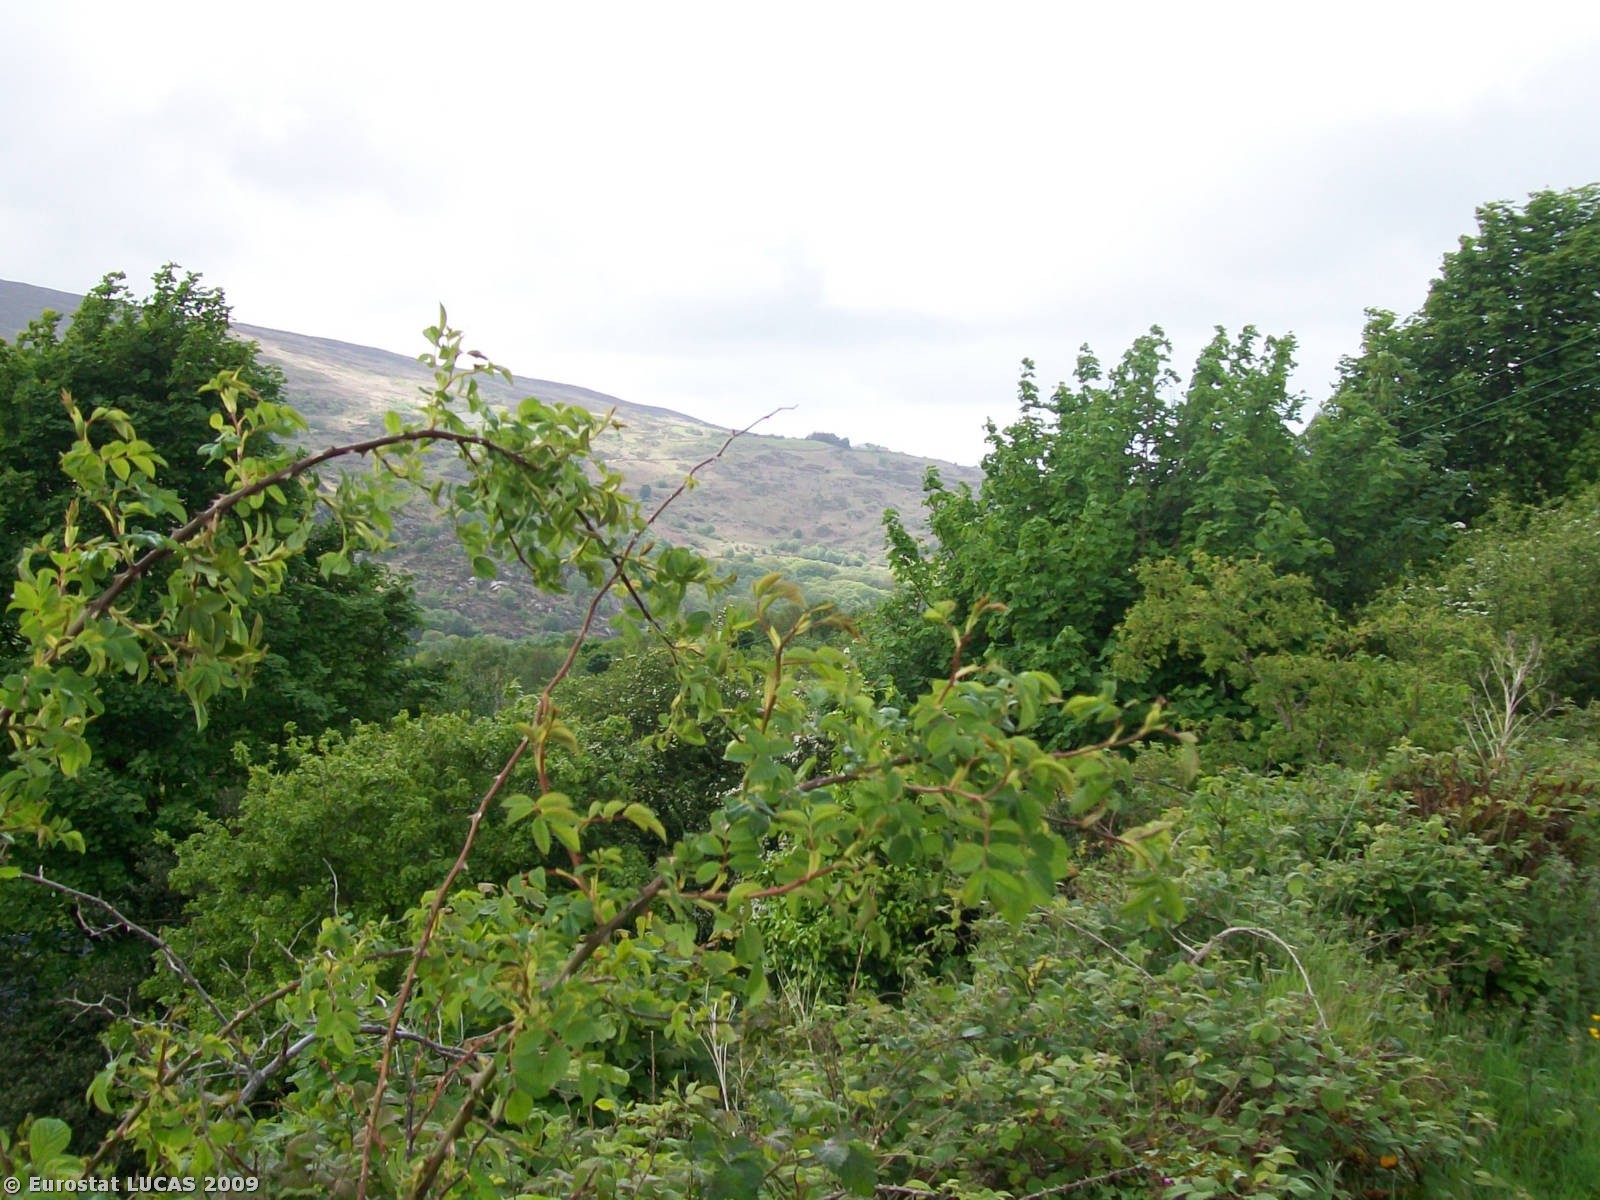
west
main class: Woodland
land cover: Broadleaved woodland
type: acidophilous oak and oak-birch forest
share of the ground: > 75 %
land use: Unused
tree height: > 5 m
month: May
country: GB
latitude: 53.1337
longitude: -4.1321
